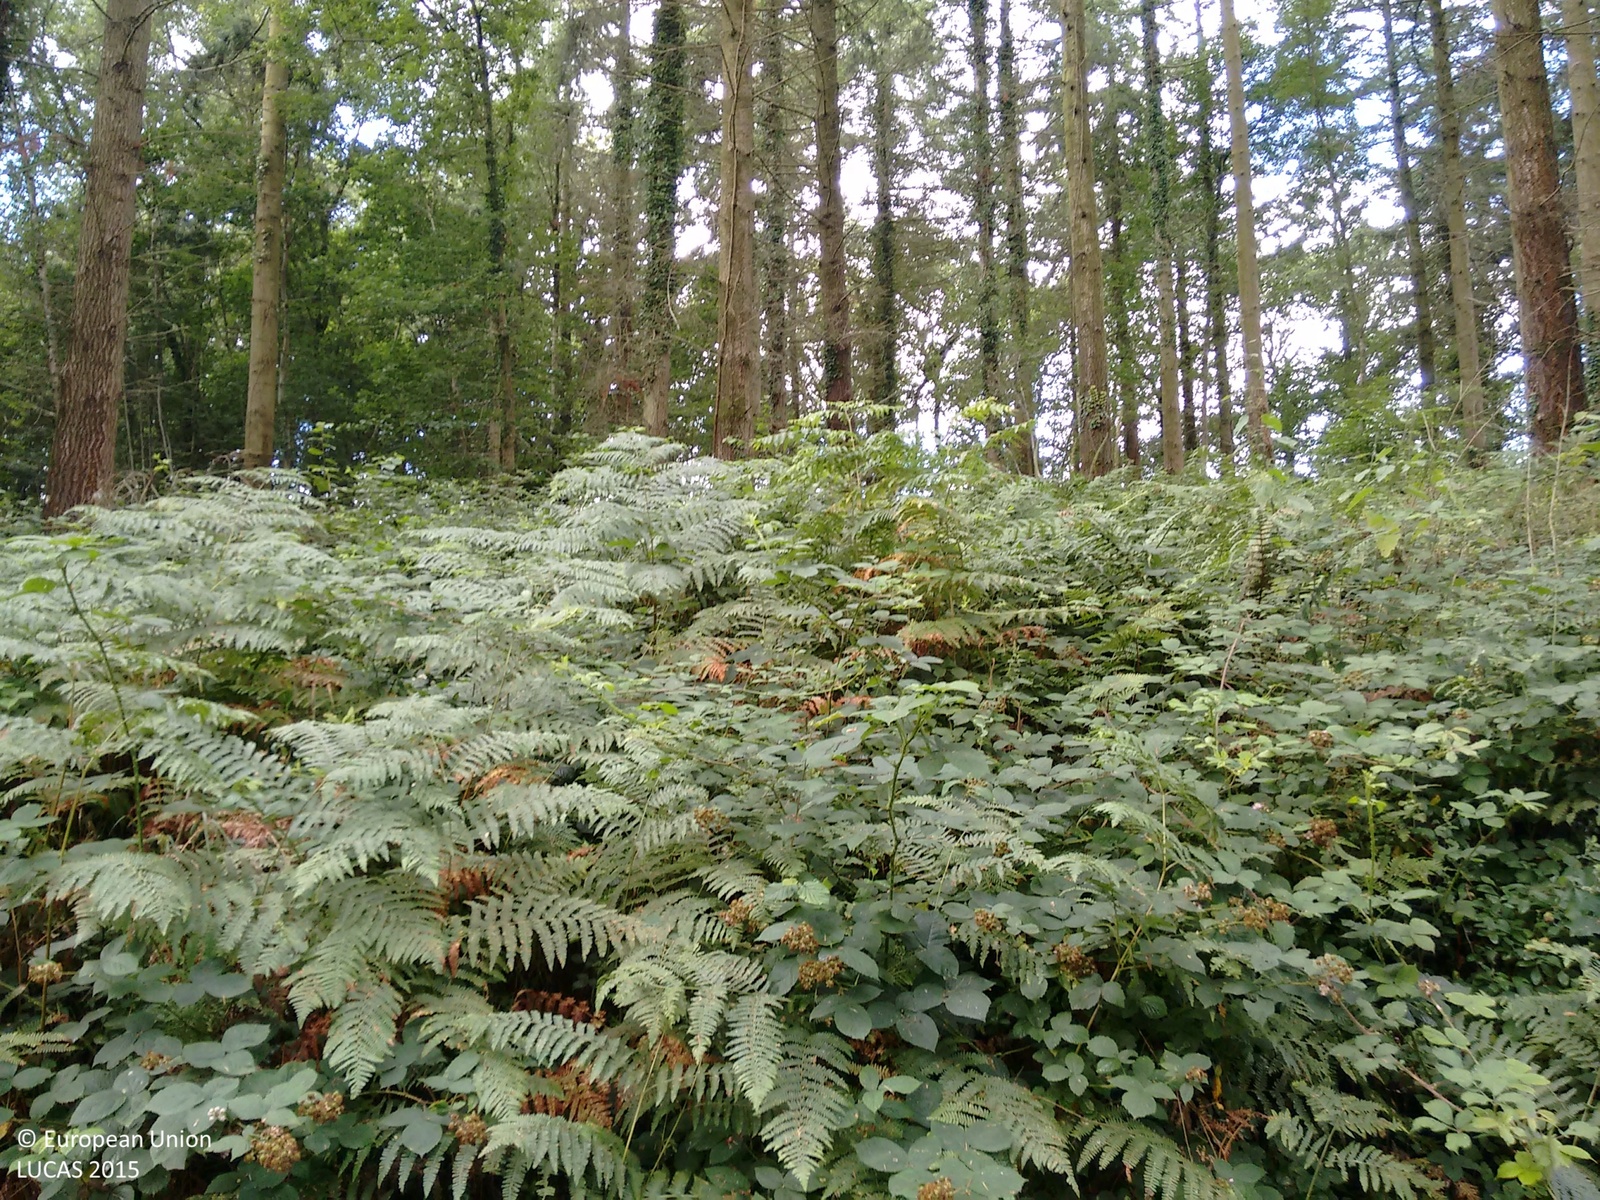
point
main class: Woodland
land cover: Spruce dominated coniferous woodland
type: exotic forest
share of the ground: > 75 %
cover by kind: coniferous forest trees 100 %
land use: Forestry
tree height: > 5 m
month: August
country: GB
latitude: 50.7482
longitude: -3.6215
